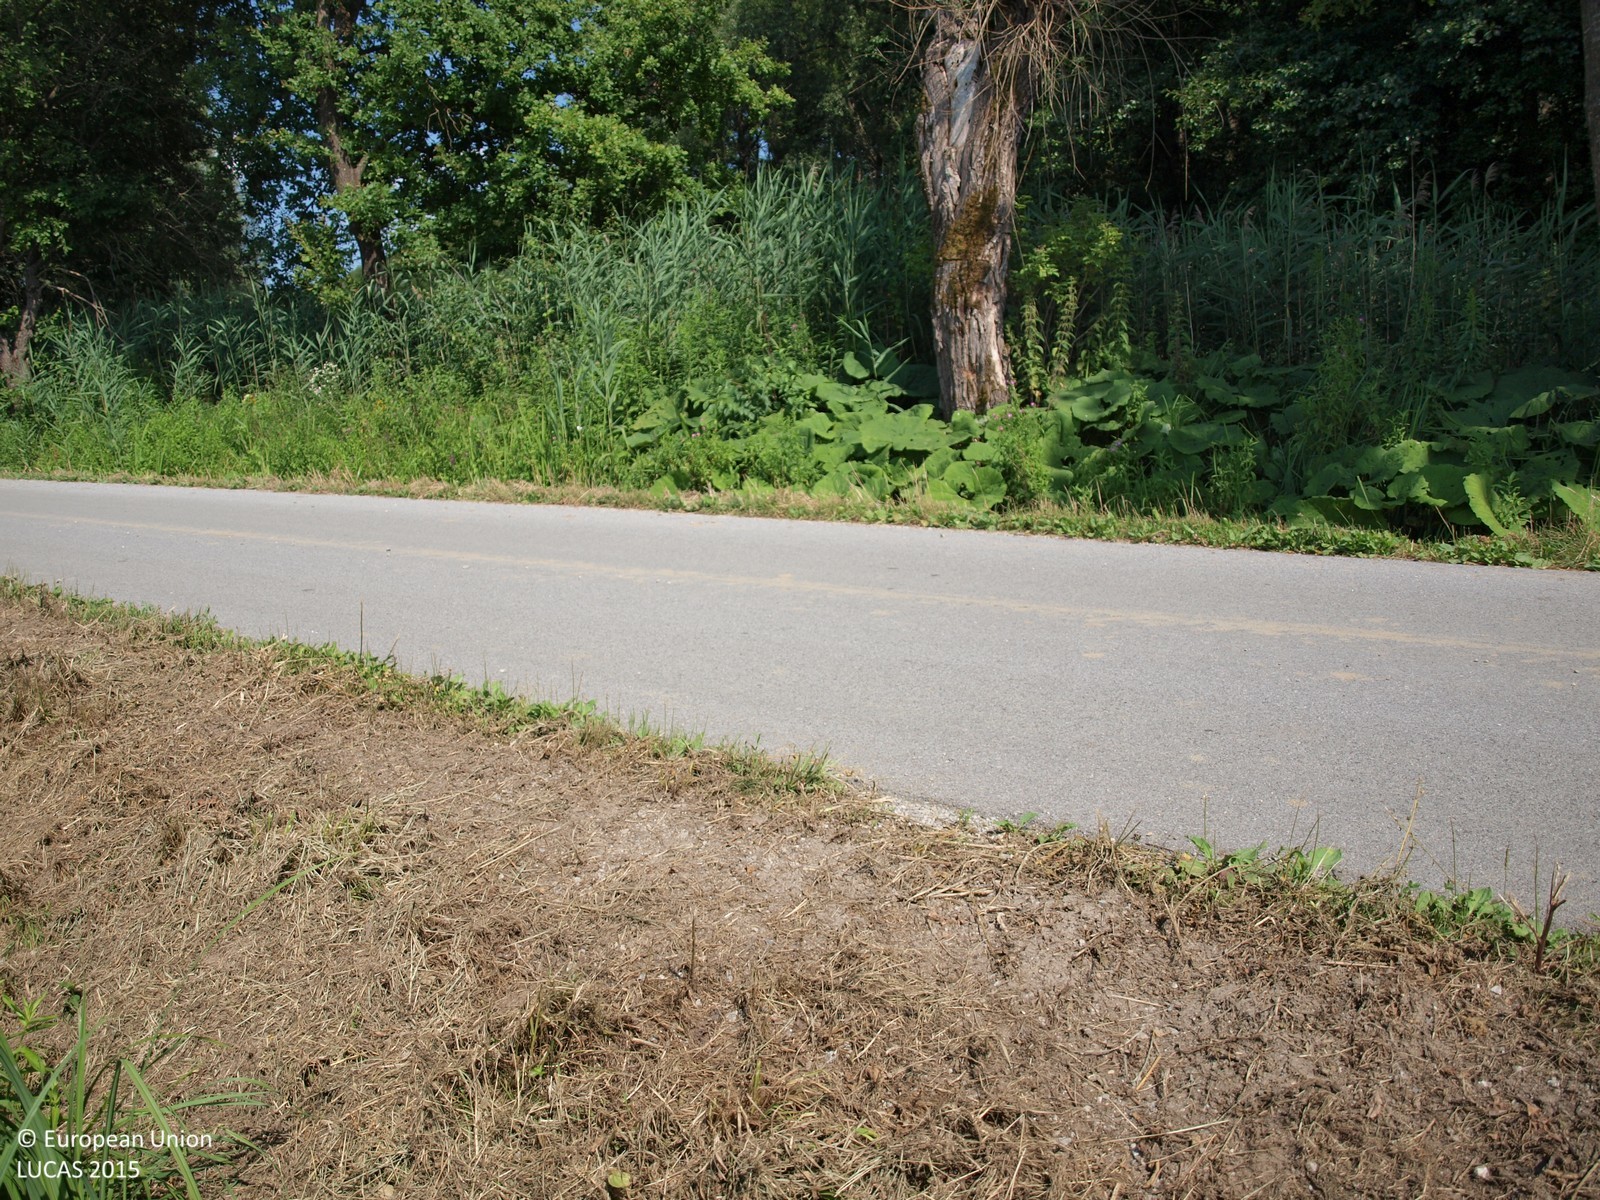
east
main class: Grassland
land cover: Grassland without tree/shrub cover
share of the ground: > 75 %
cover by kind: herbaceous plants 100 %
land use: Agriculture (excluding fallow land and kitchen gardens)
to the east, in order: Grassland without tree/shrub cover; Paved roads, cycling and walking lanes; Inland marshes; Broadleaved woodland; Maize; Shrubland with sparse tree cover; Maize; Rape and turnip rape; Potatoes; Maize
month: July
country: HR
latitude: 46.1485
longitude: 15.9674
